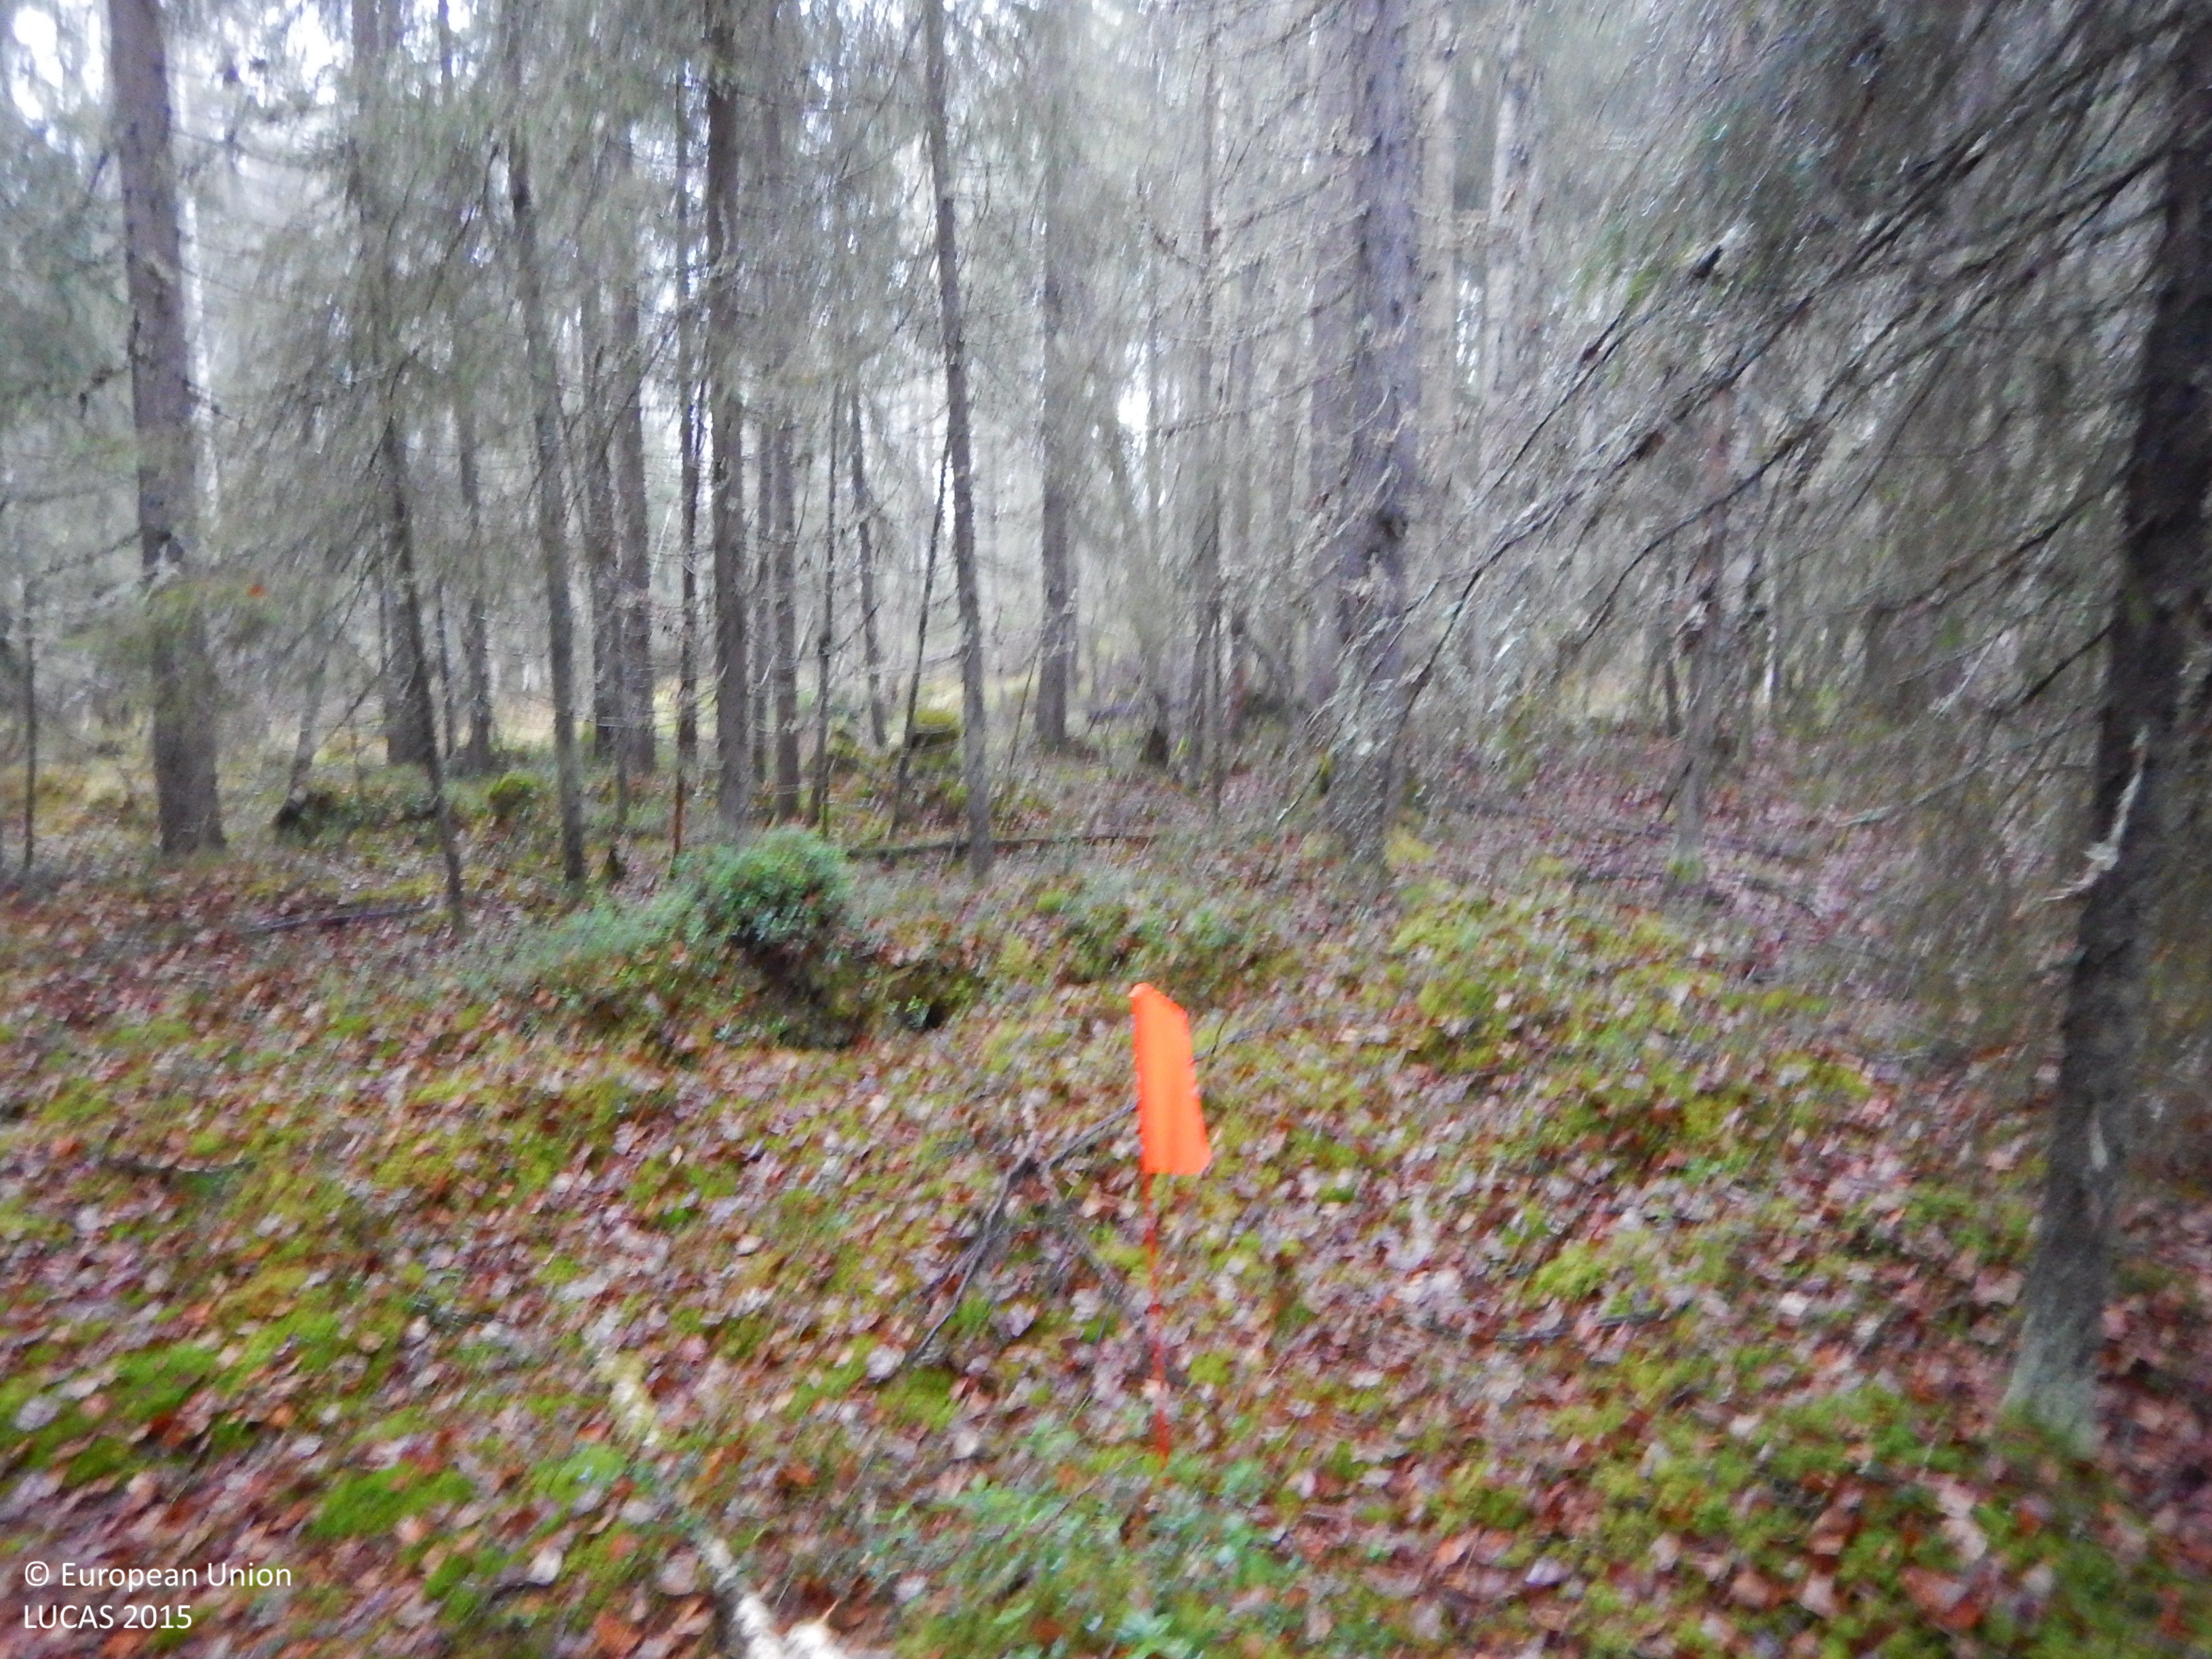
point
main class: Woodland
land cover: Spruce dominated mixed woodland
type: boreal forest
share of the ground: > 75 %
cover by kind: coniferous forest trees 60 %, broadleaved forest trees 20 %, shrubs 10 %, herbaceous plants 5 %, lichens and mosses 5 %
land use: Forestry
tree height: > 5 m
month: November
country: SE
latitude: 65.1402
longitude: 20.5665
